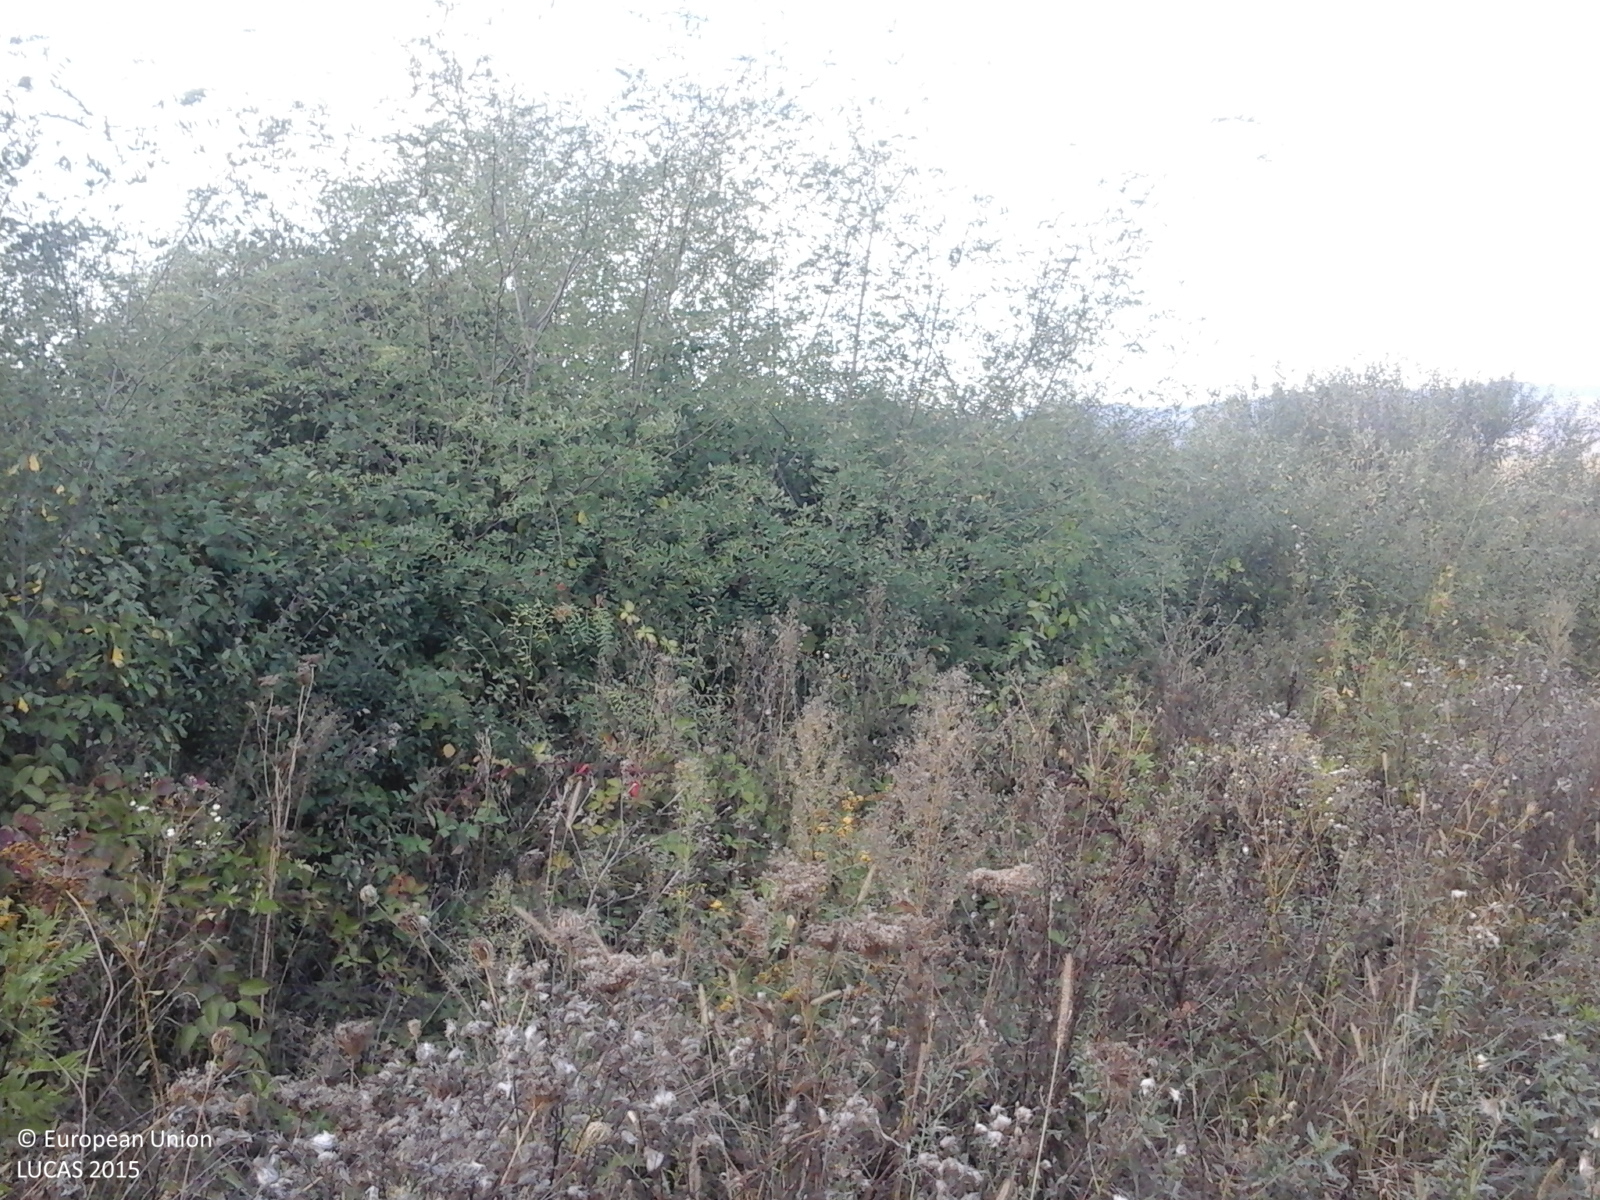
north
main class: Cropland
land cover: Maize
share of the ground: > 75 %
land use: Agriculture (excluding fallow land and kitchen gardens)
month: September
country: RO
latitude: 47.6626
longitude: 23.3483
